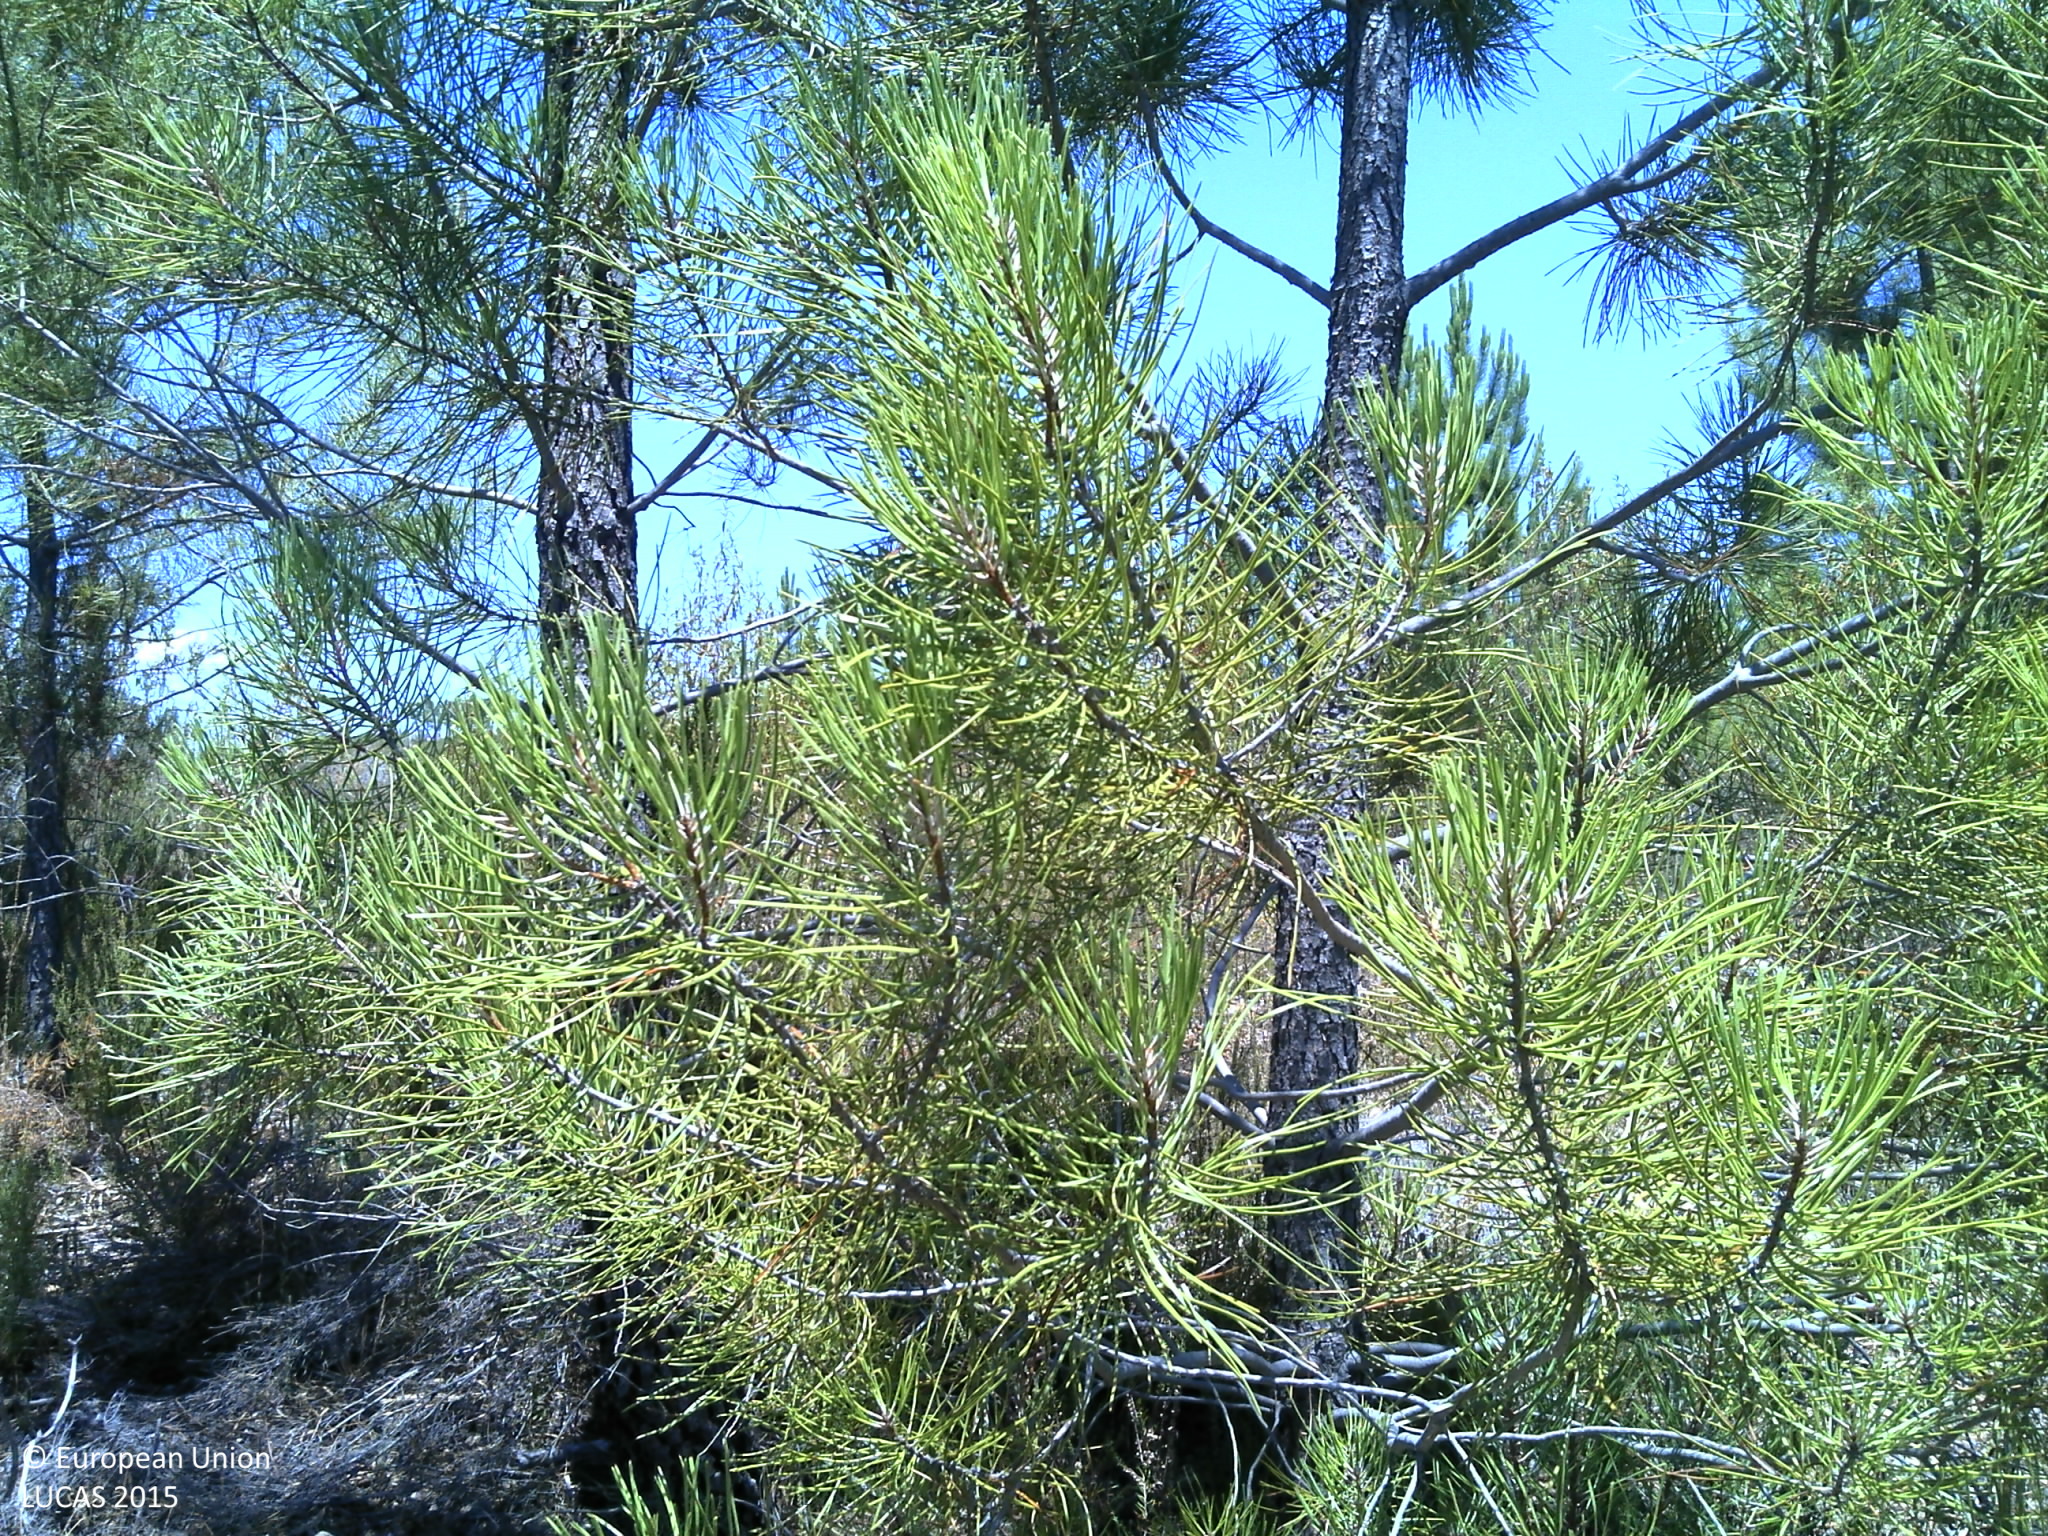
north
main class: Woodland
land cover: Pine dominated coniferous woodland
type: coniferous forest of the mediterranean region
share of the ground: 10 - 25 %
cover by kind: unconsolidated bare surface 40 %, shrubs 30 %, coniferous forest trees 20 %, consolidated bare surface 10 %
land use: Forestry
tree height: < 5 m
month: July
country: PT
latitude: 39.7623
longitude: -7.7419
